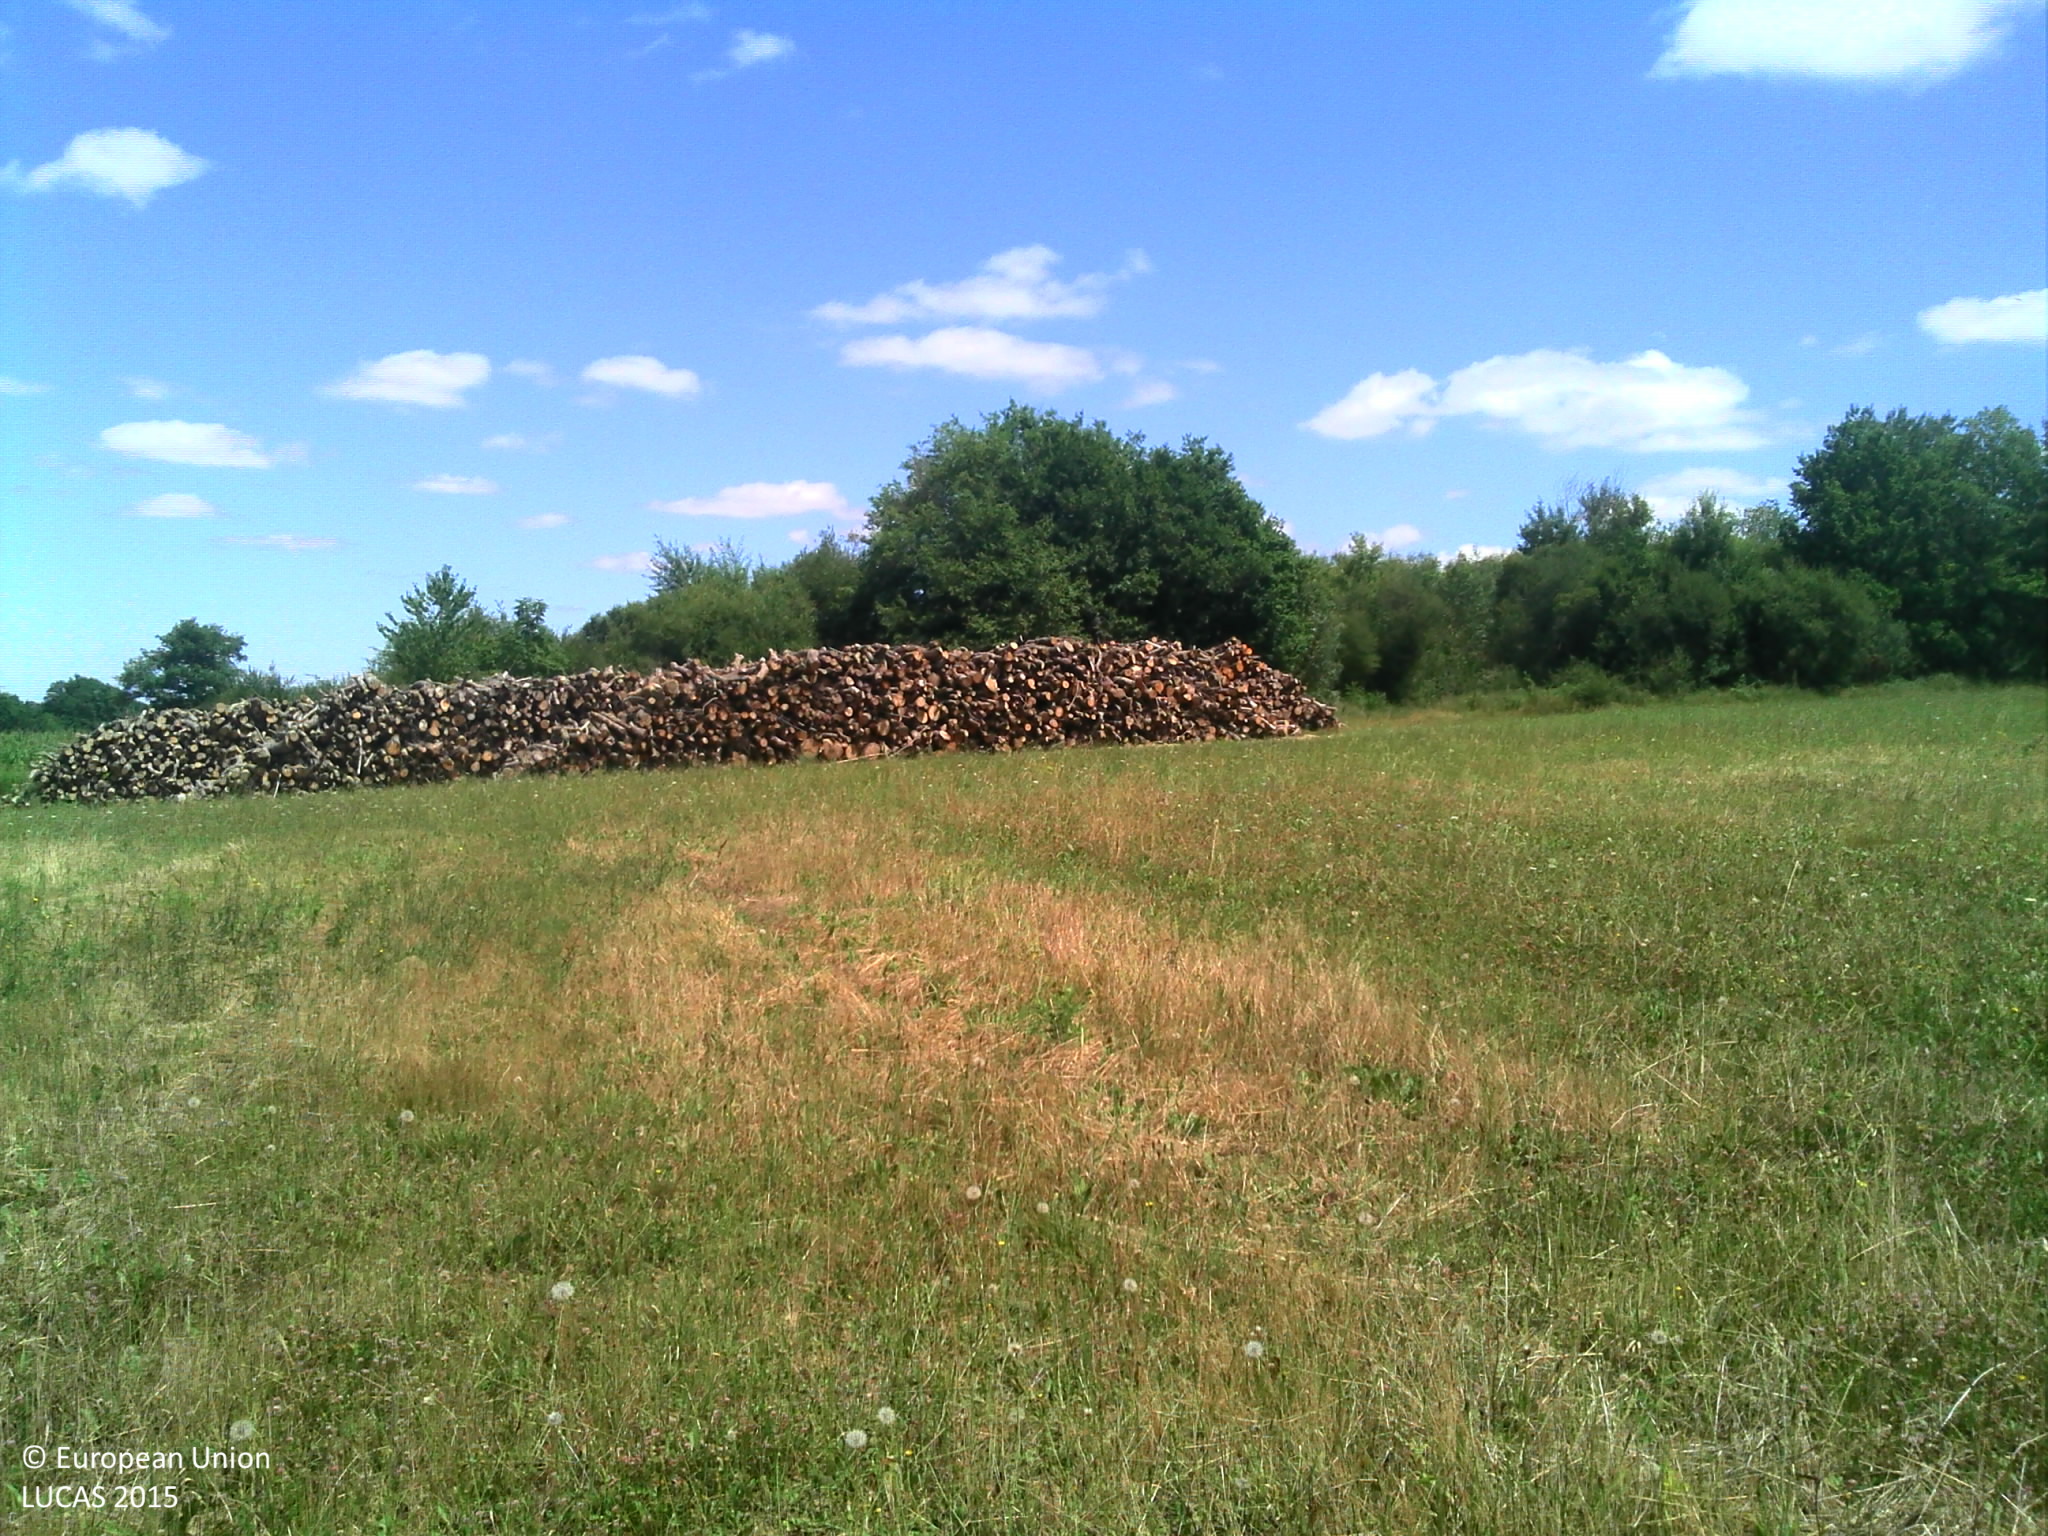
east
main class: Grassland
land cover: Grassland without tree/shrub cover
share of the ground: > 75 %
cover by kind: herbaceous plants 100 %
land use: Agriculture (excluding fallow land and kitchen gardens)
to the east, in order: Grassland without tree/shrub cover; Tracks; Grass margins; Broadleaved woodland; Grass margins; Paved roads, cycling and walking lanes; Fences; Grass margins; Sunflower
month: July
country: FR
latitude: 43.2471
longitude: 0.7517
